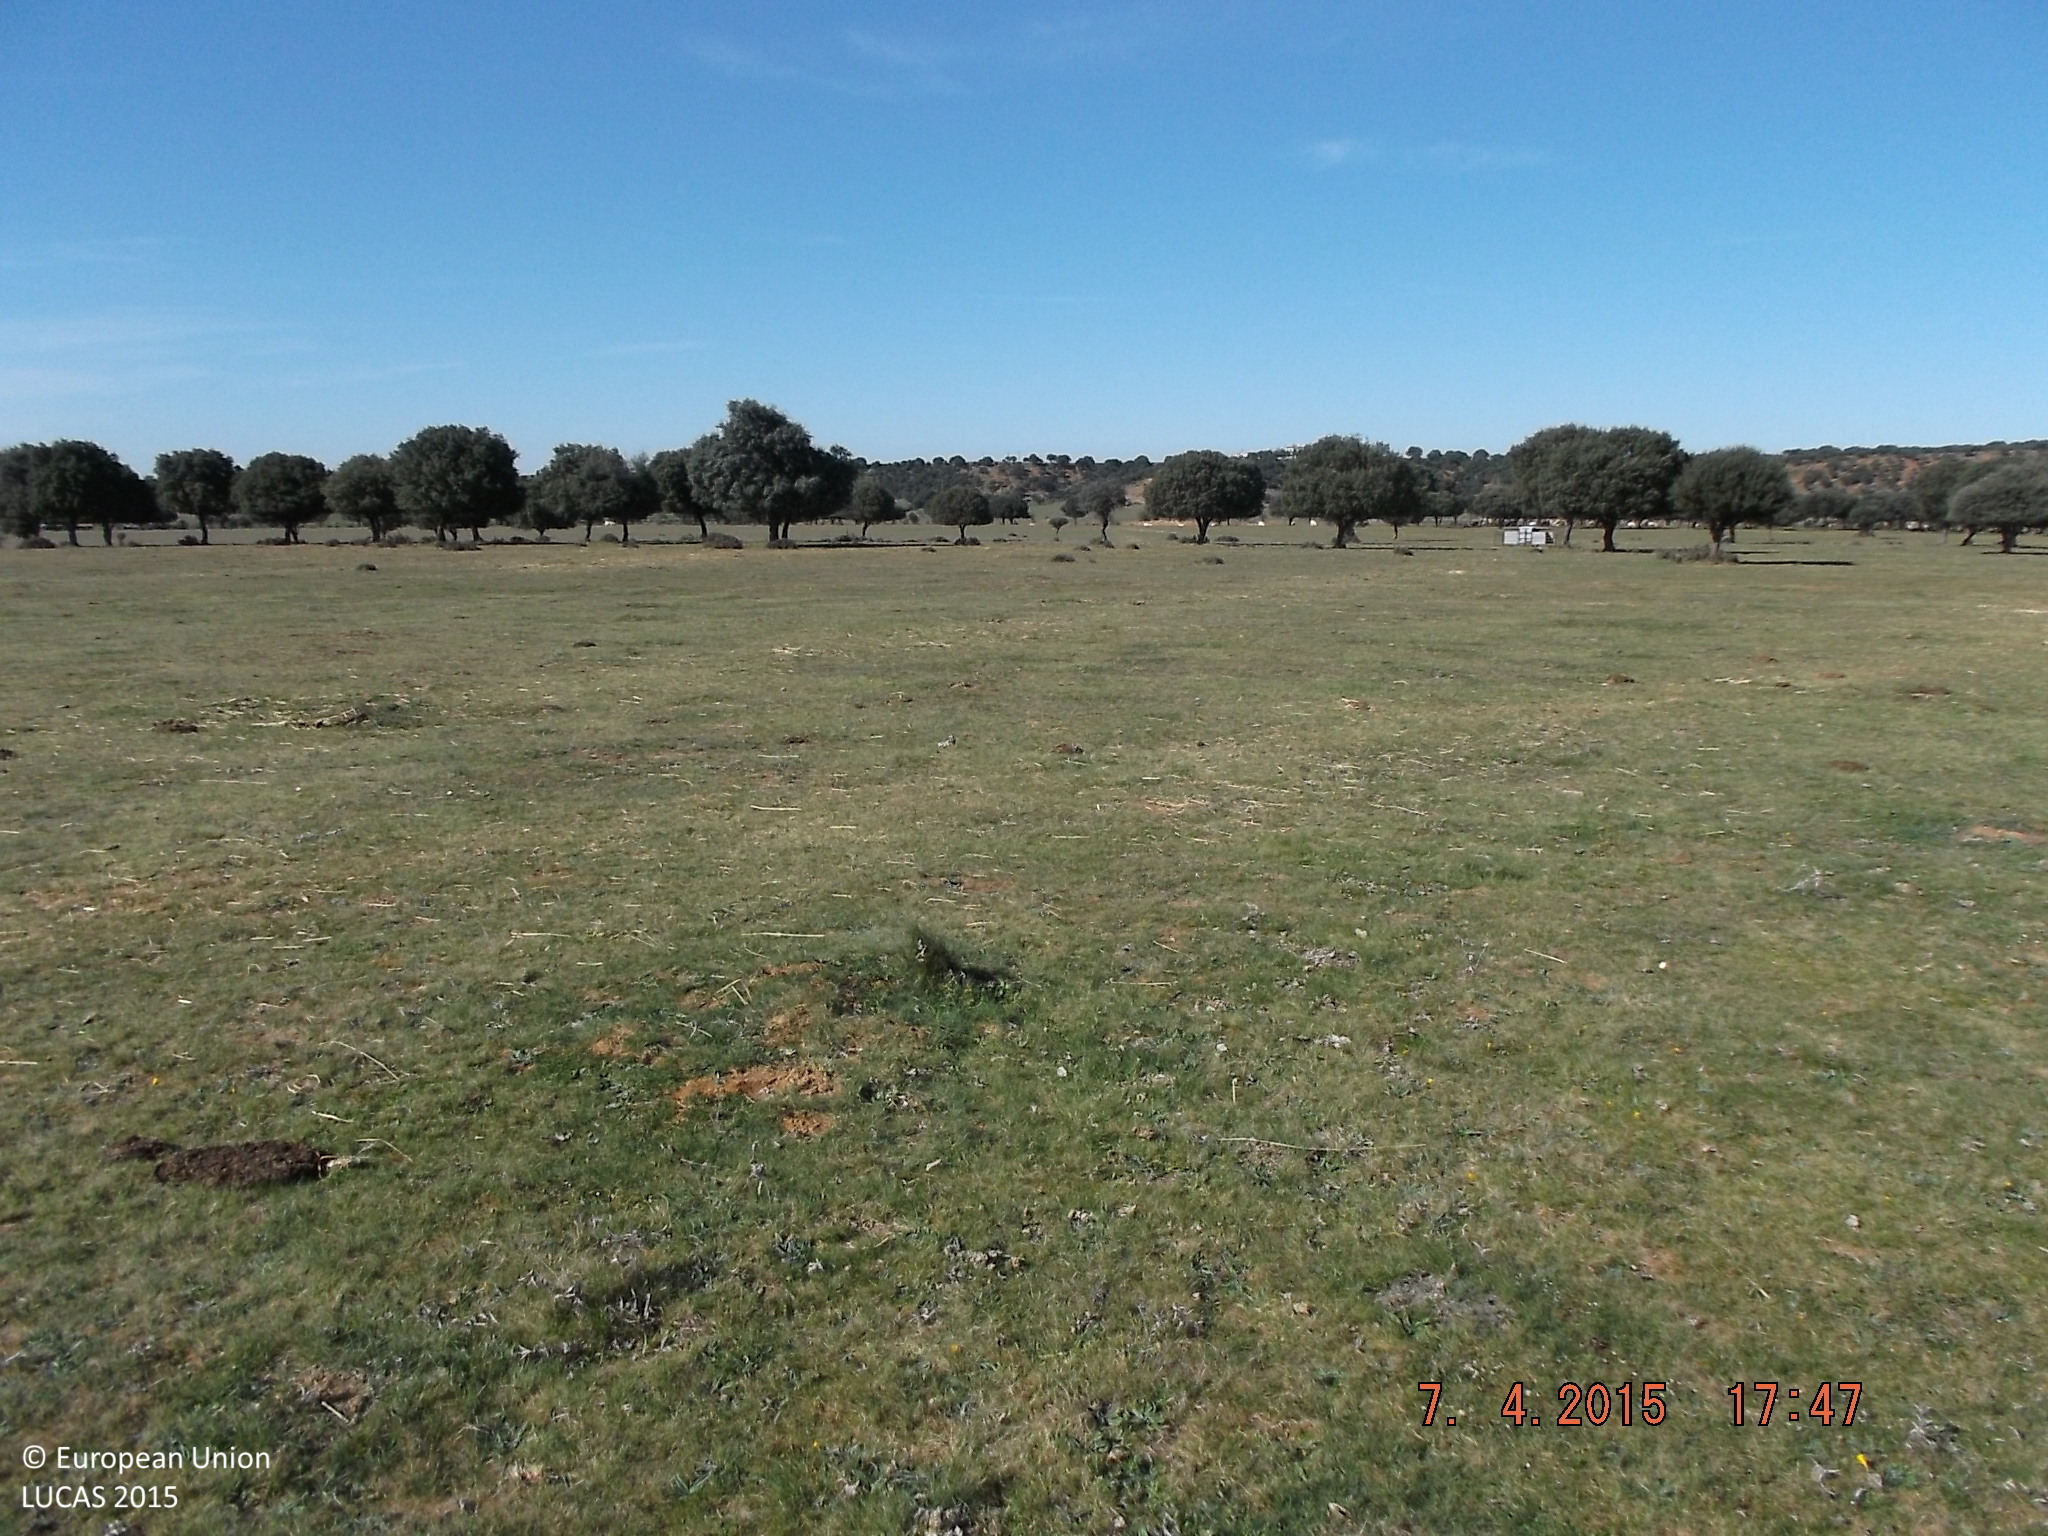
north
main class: Grassland
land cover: Grassland without tree/shrub cover
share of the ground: > 75 %
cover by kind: herbaceous plants 100 %
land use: Agriculture (excluding fallow land and kitchen gardens)
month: April
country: ES
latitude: 40.8139
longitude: -5.9308
